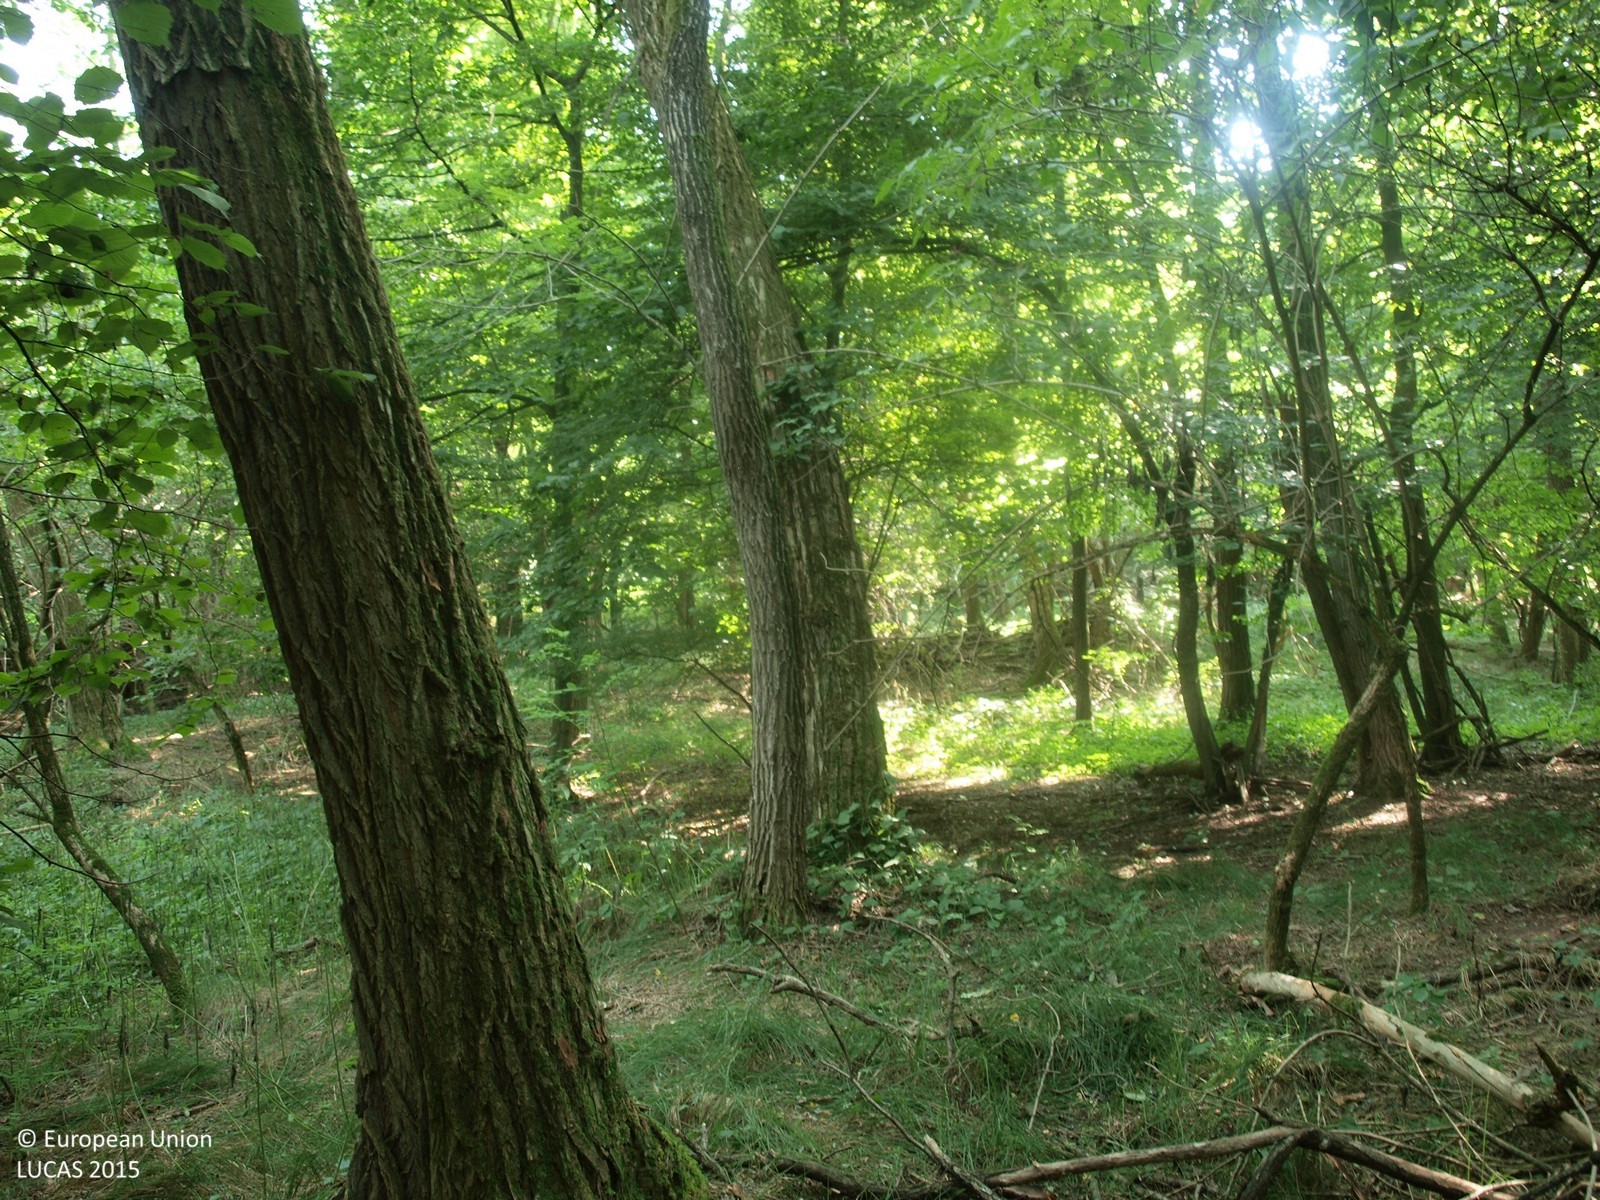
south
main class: Woodland
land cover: Broadleaved woodland
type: mesophytic deciduous forest
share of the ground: > 75 %
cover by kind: broadleaved forest trees 100 %
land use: Forestry
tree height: > 5 m
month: August
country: HR
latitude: 45.9621
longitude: 16.6713
